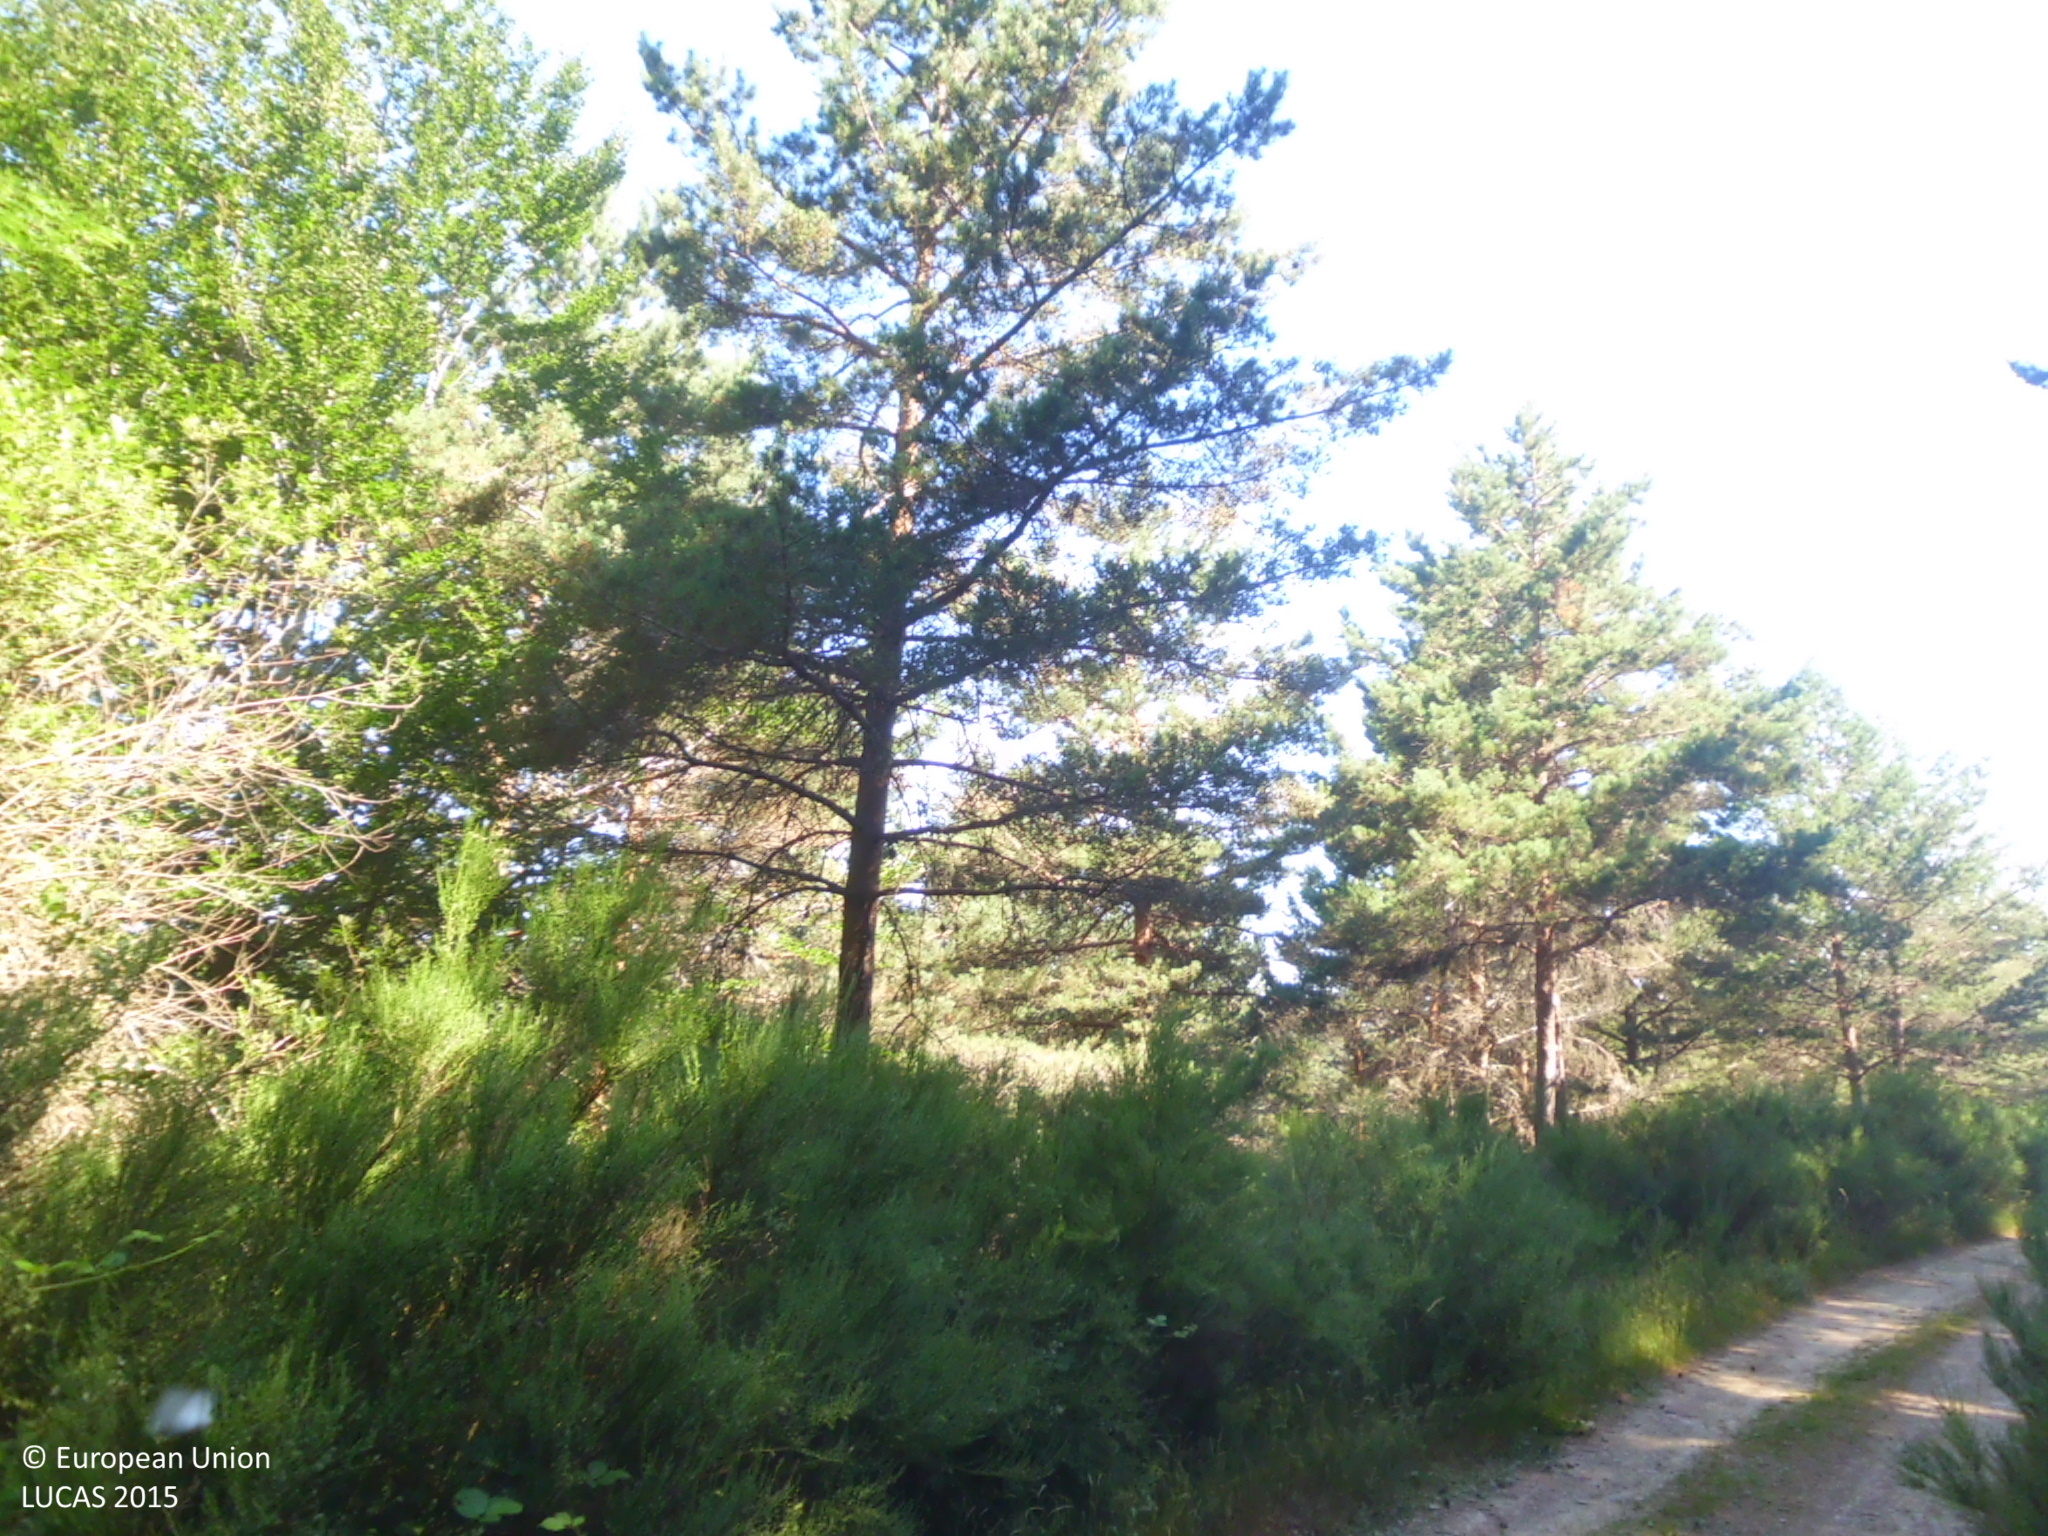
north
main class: Woodland
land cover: Pine dominated coniferous woodland
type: coniferous forest of the mediterranean region
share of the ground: > 75 %
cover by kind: coniferous forest trees 95 %, shrubs 5 %
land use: Forestry
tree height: > 5 m
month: July
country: ES
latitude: 42.2204
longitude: -3.3684
